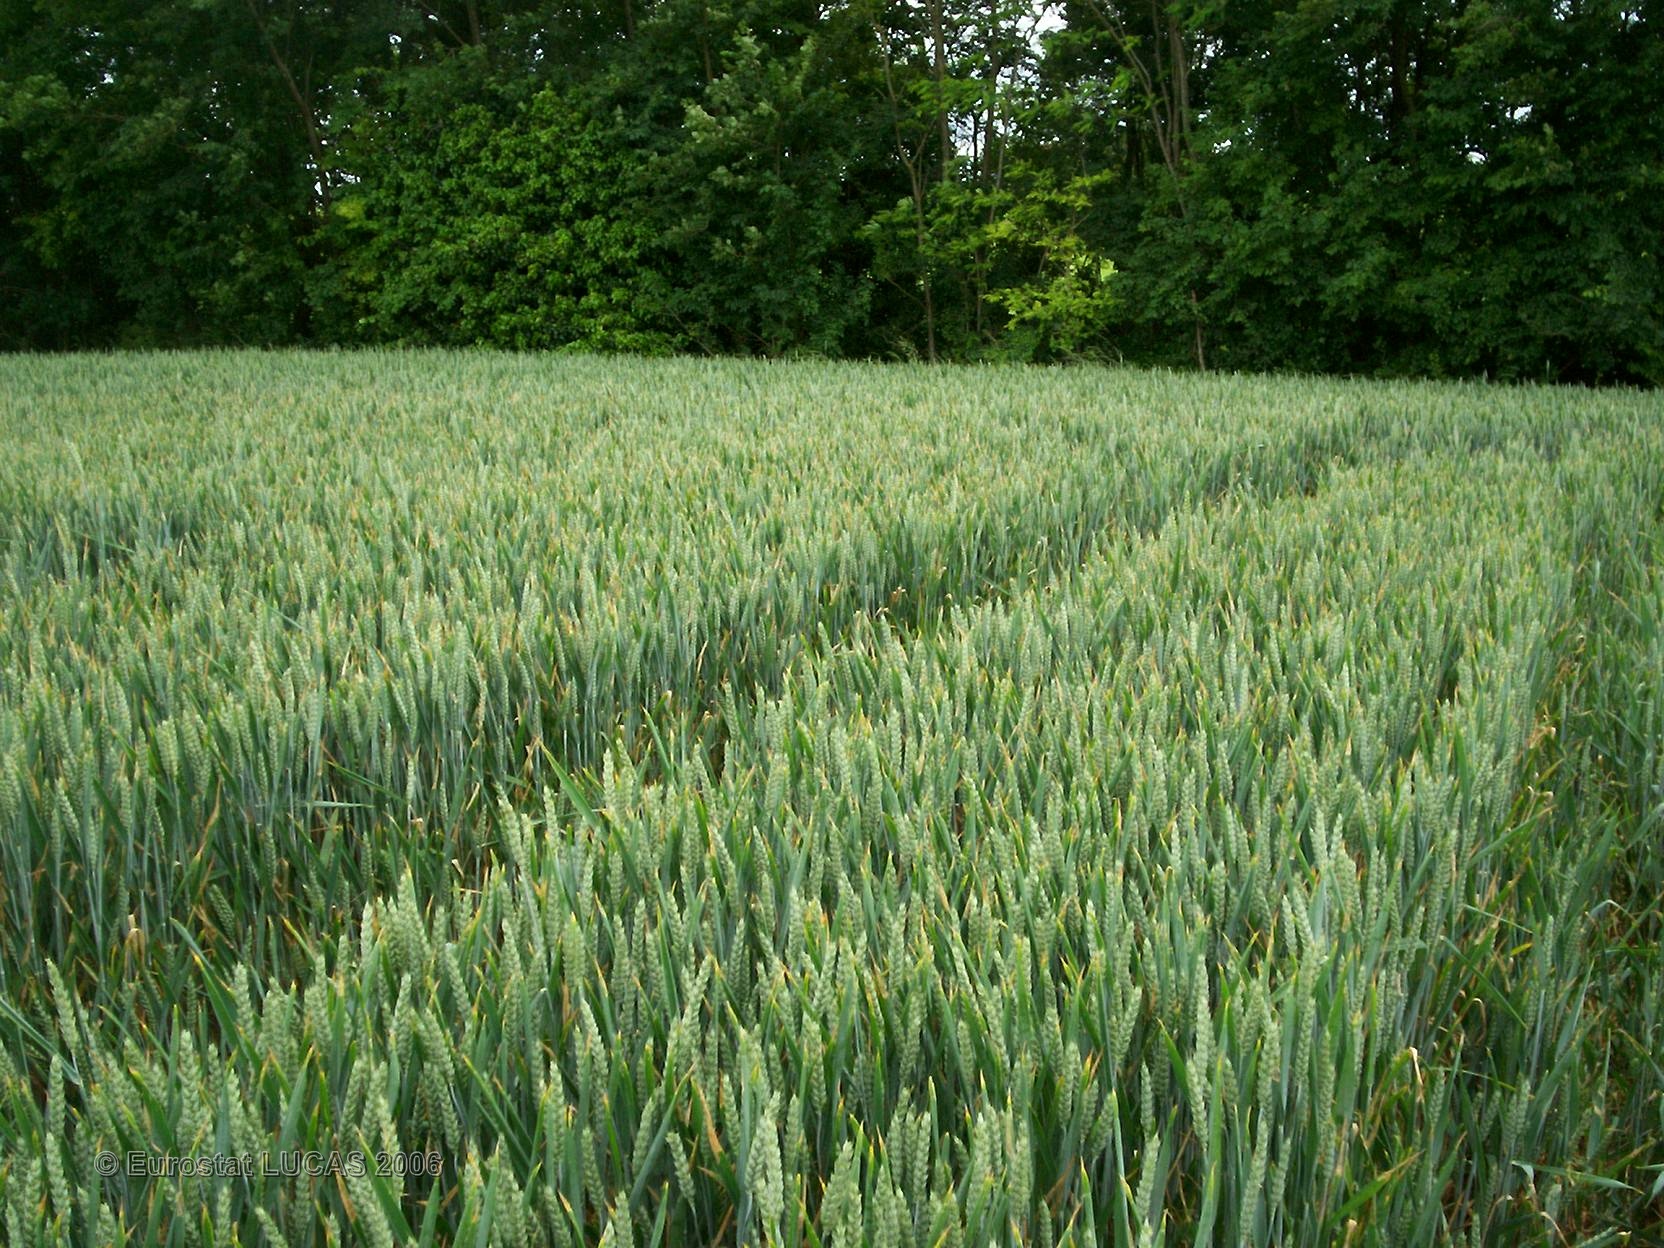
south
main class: Cropland
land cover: Common wheat
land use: Agriculture (excluding fallow land and kitchen gardens)
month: May
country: FR
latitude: 43.6113
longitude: 0.9676
